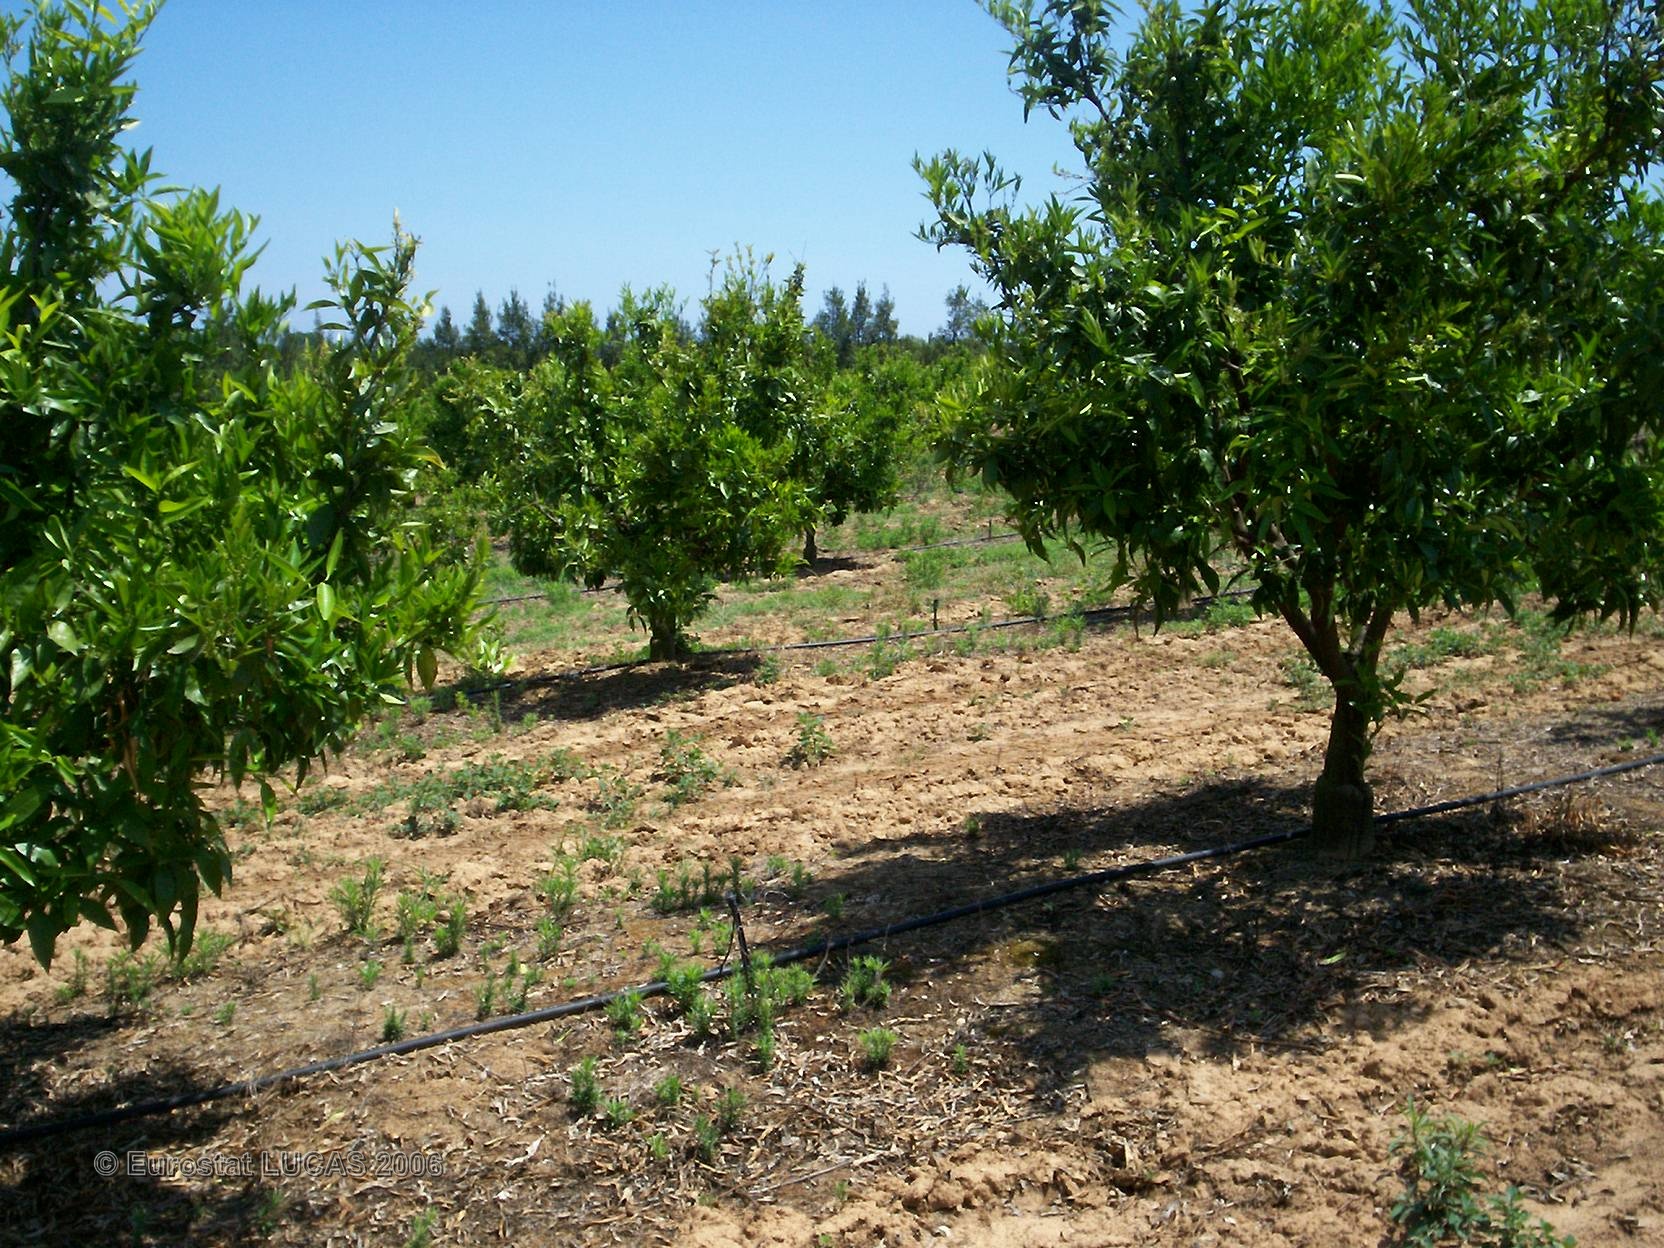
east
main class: Cropland
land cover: Other citrus fruit
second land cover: Bare land
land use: Agriculture (excluding fallow land and kitchen gardens)
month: June
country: FR
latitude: 42.1652
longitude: 9.5297
